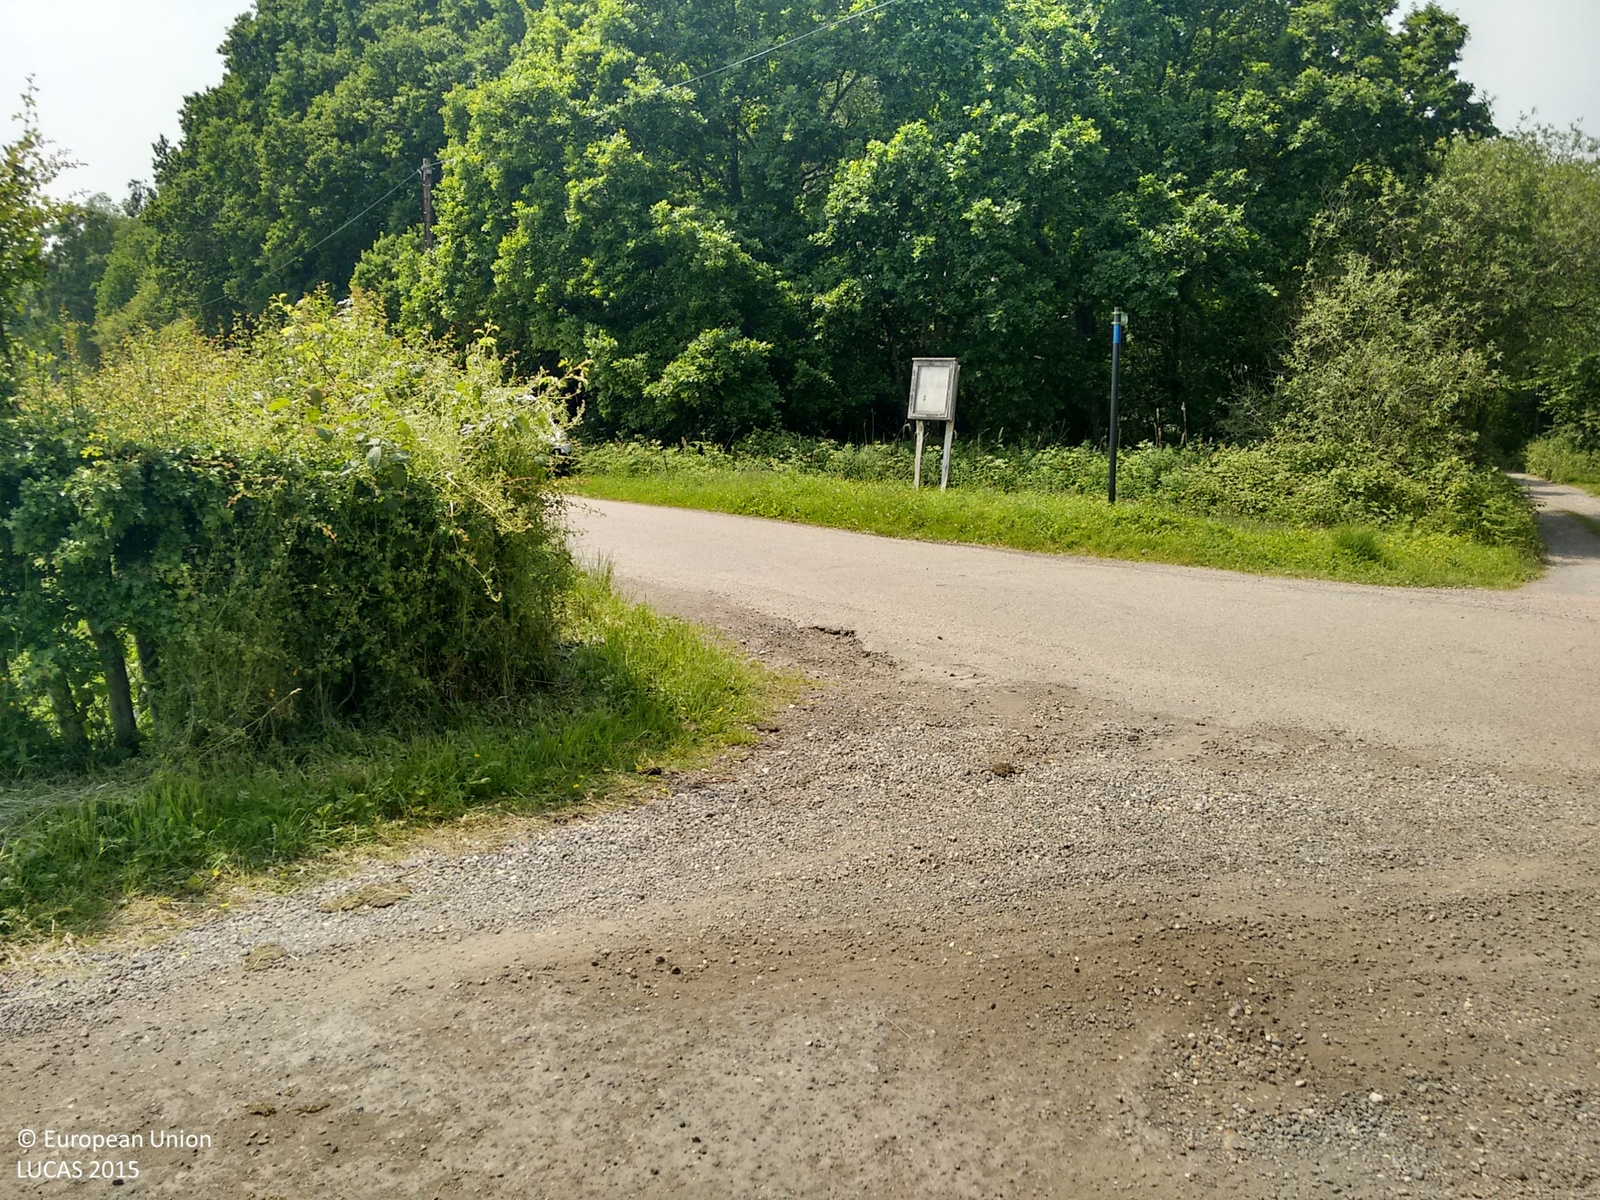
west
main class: Grassland
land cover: Grassland without tree/shrub cover
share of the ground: > 75 %
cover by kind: herbaceous plants 100 %
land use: Agriculture (excluding fallow land and kitchen gardens)
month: June
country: GB
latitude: 51.0970
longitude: 0.3607
